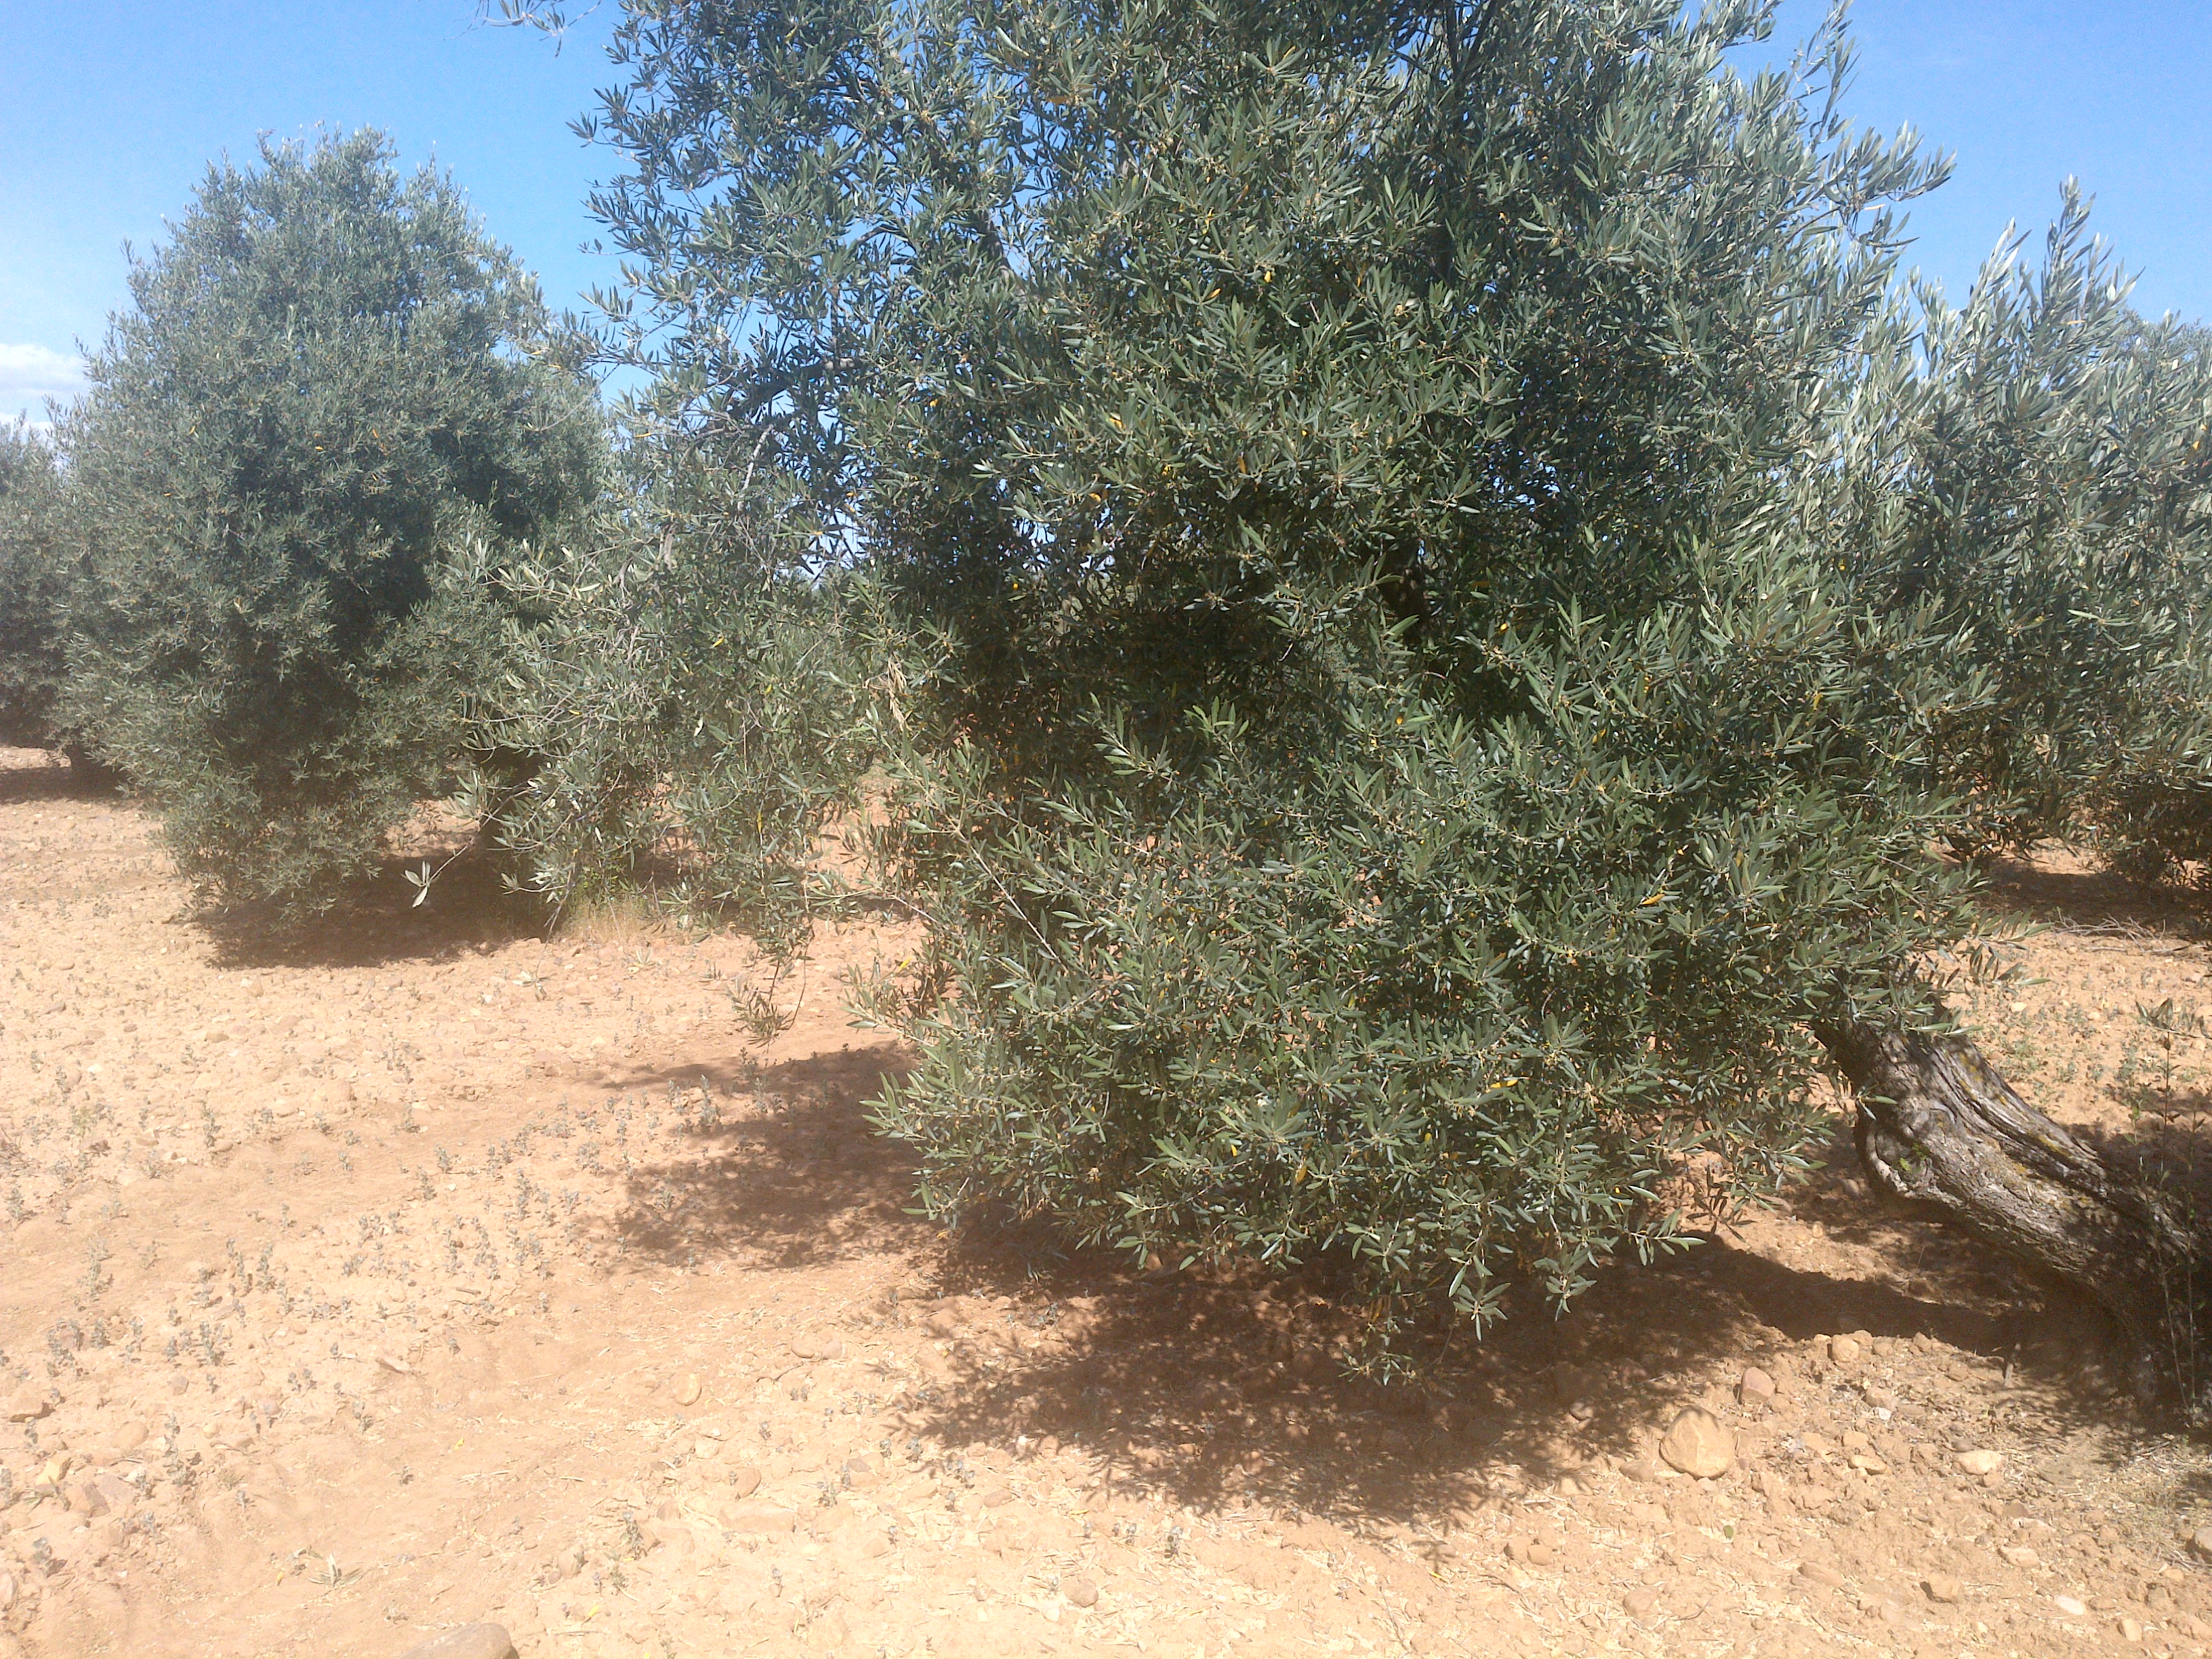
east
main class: Cropland
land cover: Olive groves
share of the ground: 50 - 75 %
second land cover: Other bare soil
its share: > 75 %
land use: Agriculture (excluding fallow land and kitchen gardens)
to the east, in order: Olive groves; Other bare soil; Electric lines; Olive groves; Grass margins; Ditches and canals; Paved roads, cycling and walking lanes; Ditches and canals; Grass margins; Olive groves
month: May
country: ES
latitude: 37.9082
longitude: -4.6742
